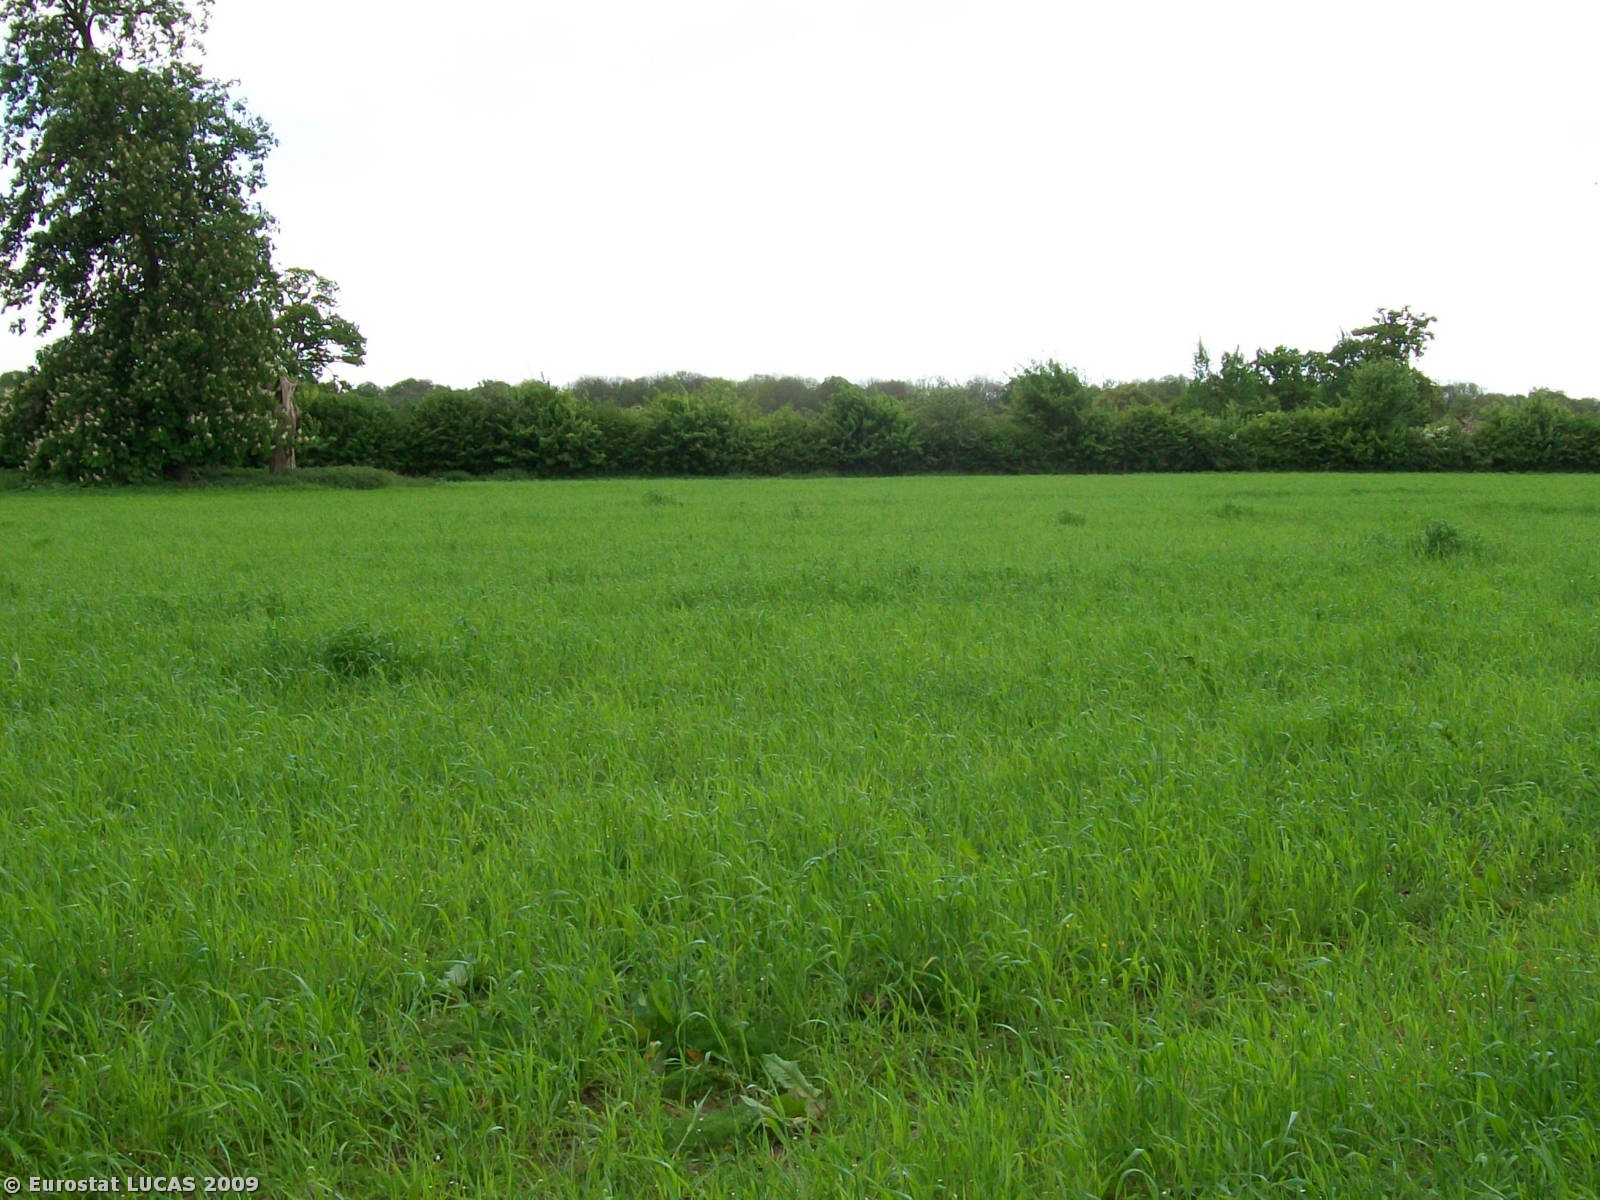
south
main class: Cropland
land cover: Barley
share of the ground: > 75 %
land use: Agriculture (excluding fallow land and kitchen gardens)
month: May
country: GB
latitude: 51.4868
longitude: -0.7706
